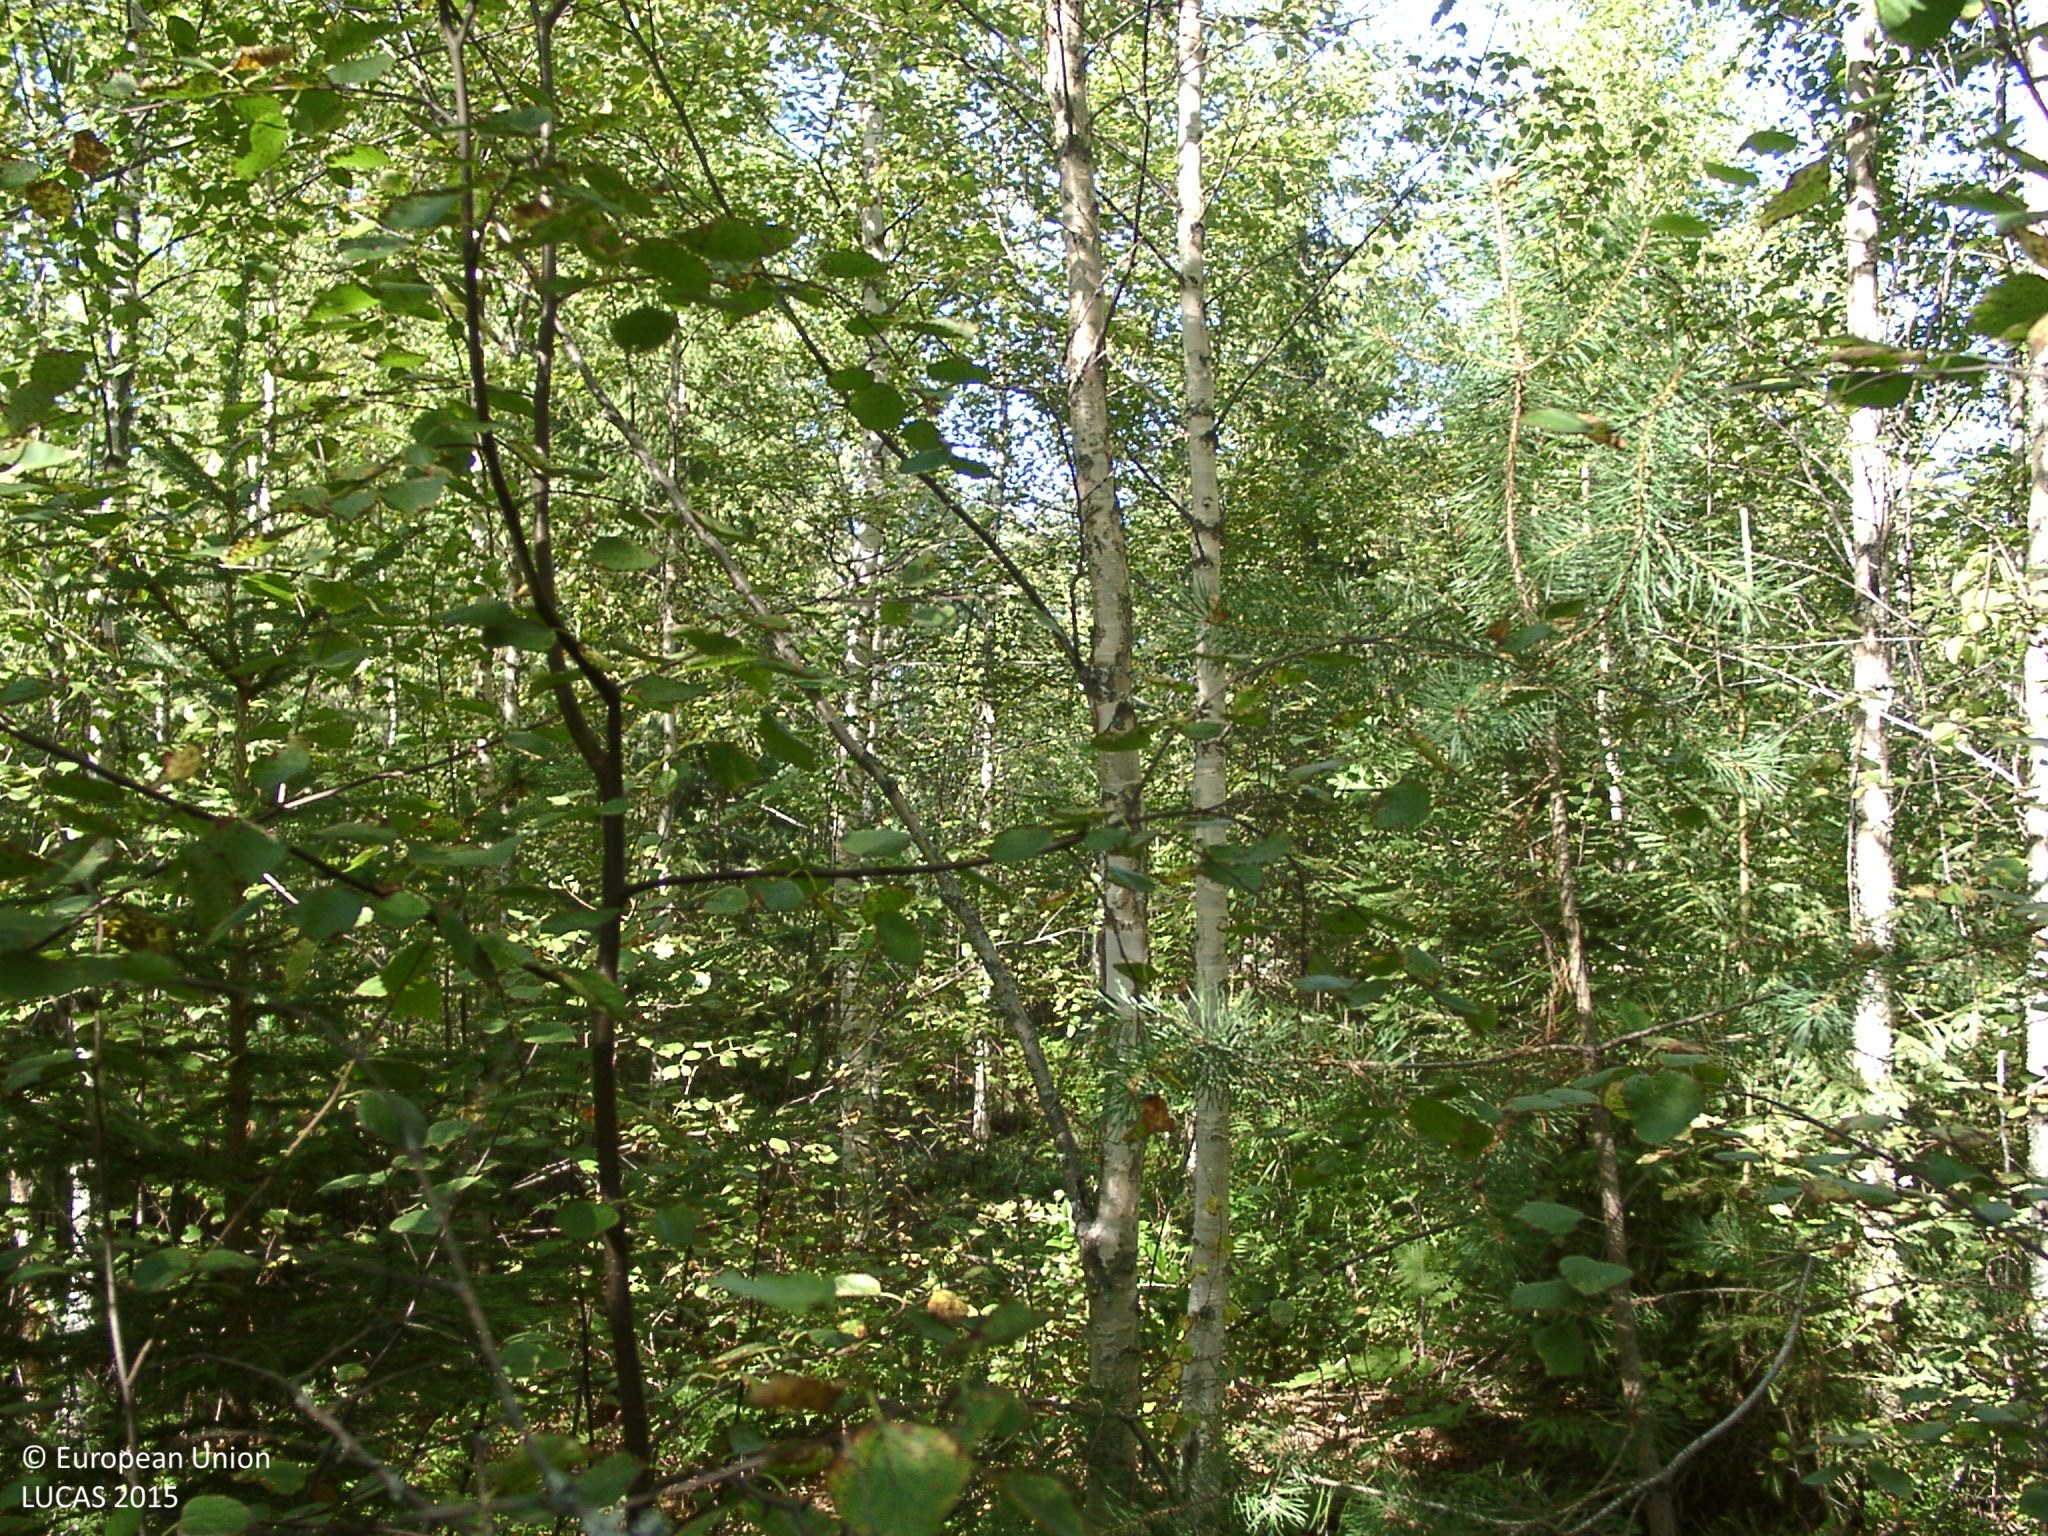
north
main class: Woodland
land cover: Broadleaved woodland
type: boreal forest
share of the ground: > 75 %
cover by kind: broadleaved forest trees 65 %, coniferous forest trees 20 %, shrubs 10 %, unconsolidated bare surface 5 %
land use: Forestry
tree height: > 5 m
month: August
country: FI
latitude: 62.4092
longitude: 25.3403
